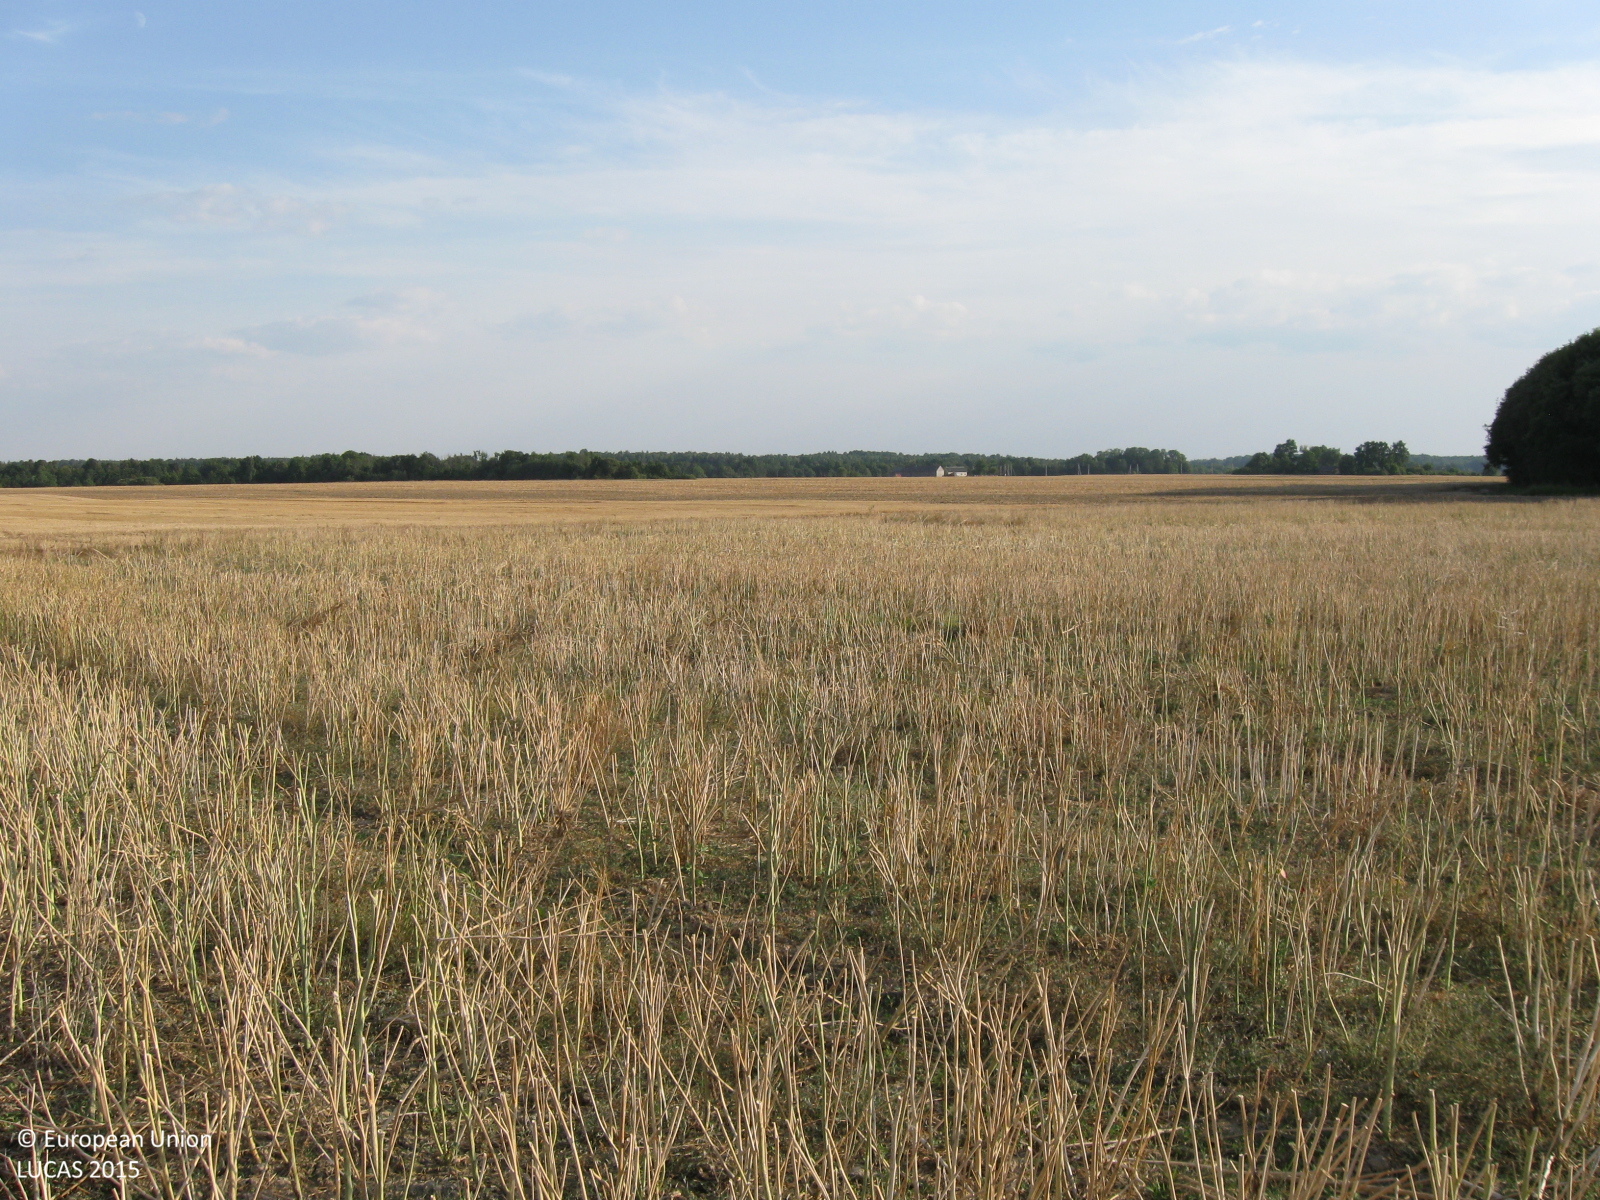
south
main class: Cropland
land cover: Rape and turnip rape
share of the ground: > 75 %
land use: Agriculture (excluding fallow land and kitchen gardens)
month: August
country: LT
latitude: 55.2812
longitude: 22.8674
